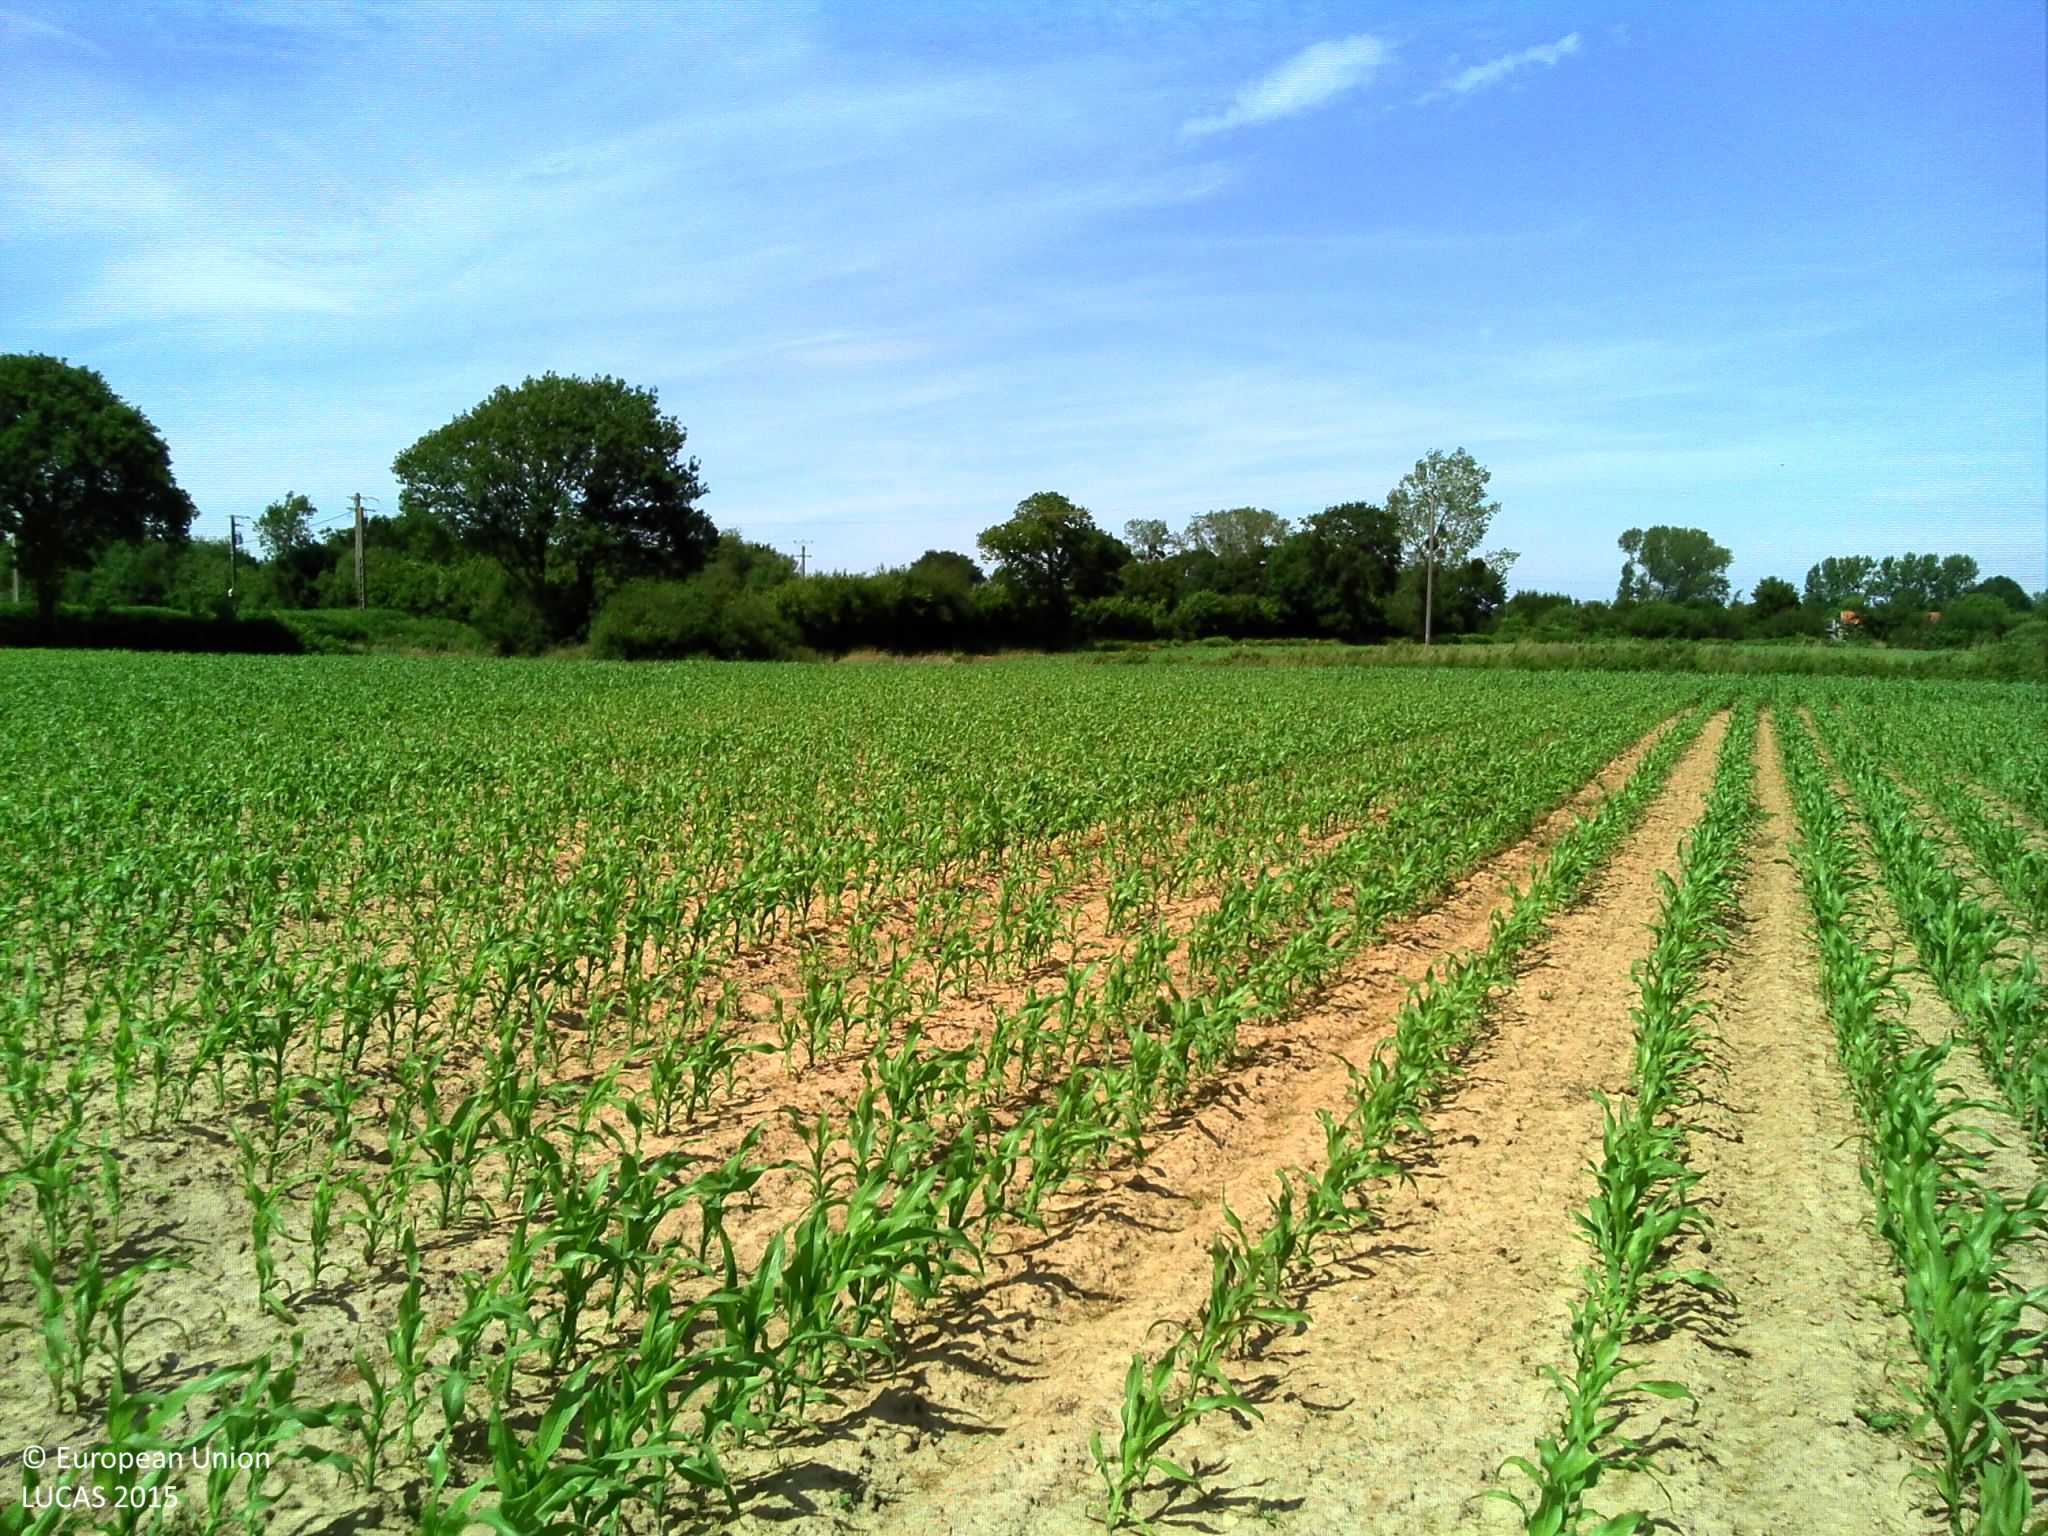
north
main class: Cropland
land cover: Maize
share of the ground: 25 - 50 %
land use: Agriculture (excluding fallow land and kitchen gardens)
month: June
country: FR
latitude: 49.1808
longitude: -1.3371
